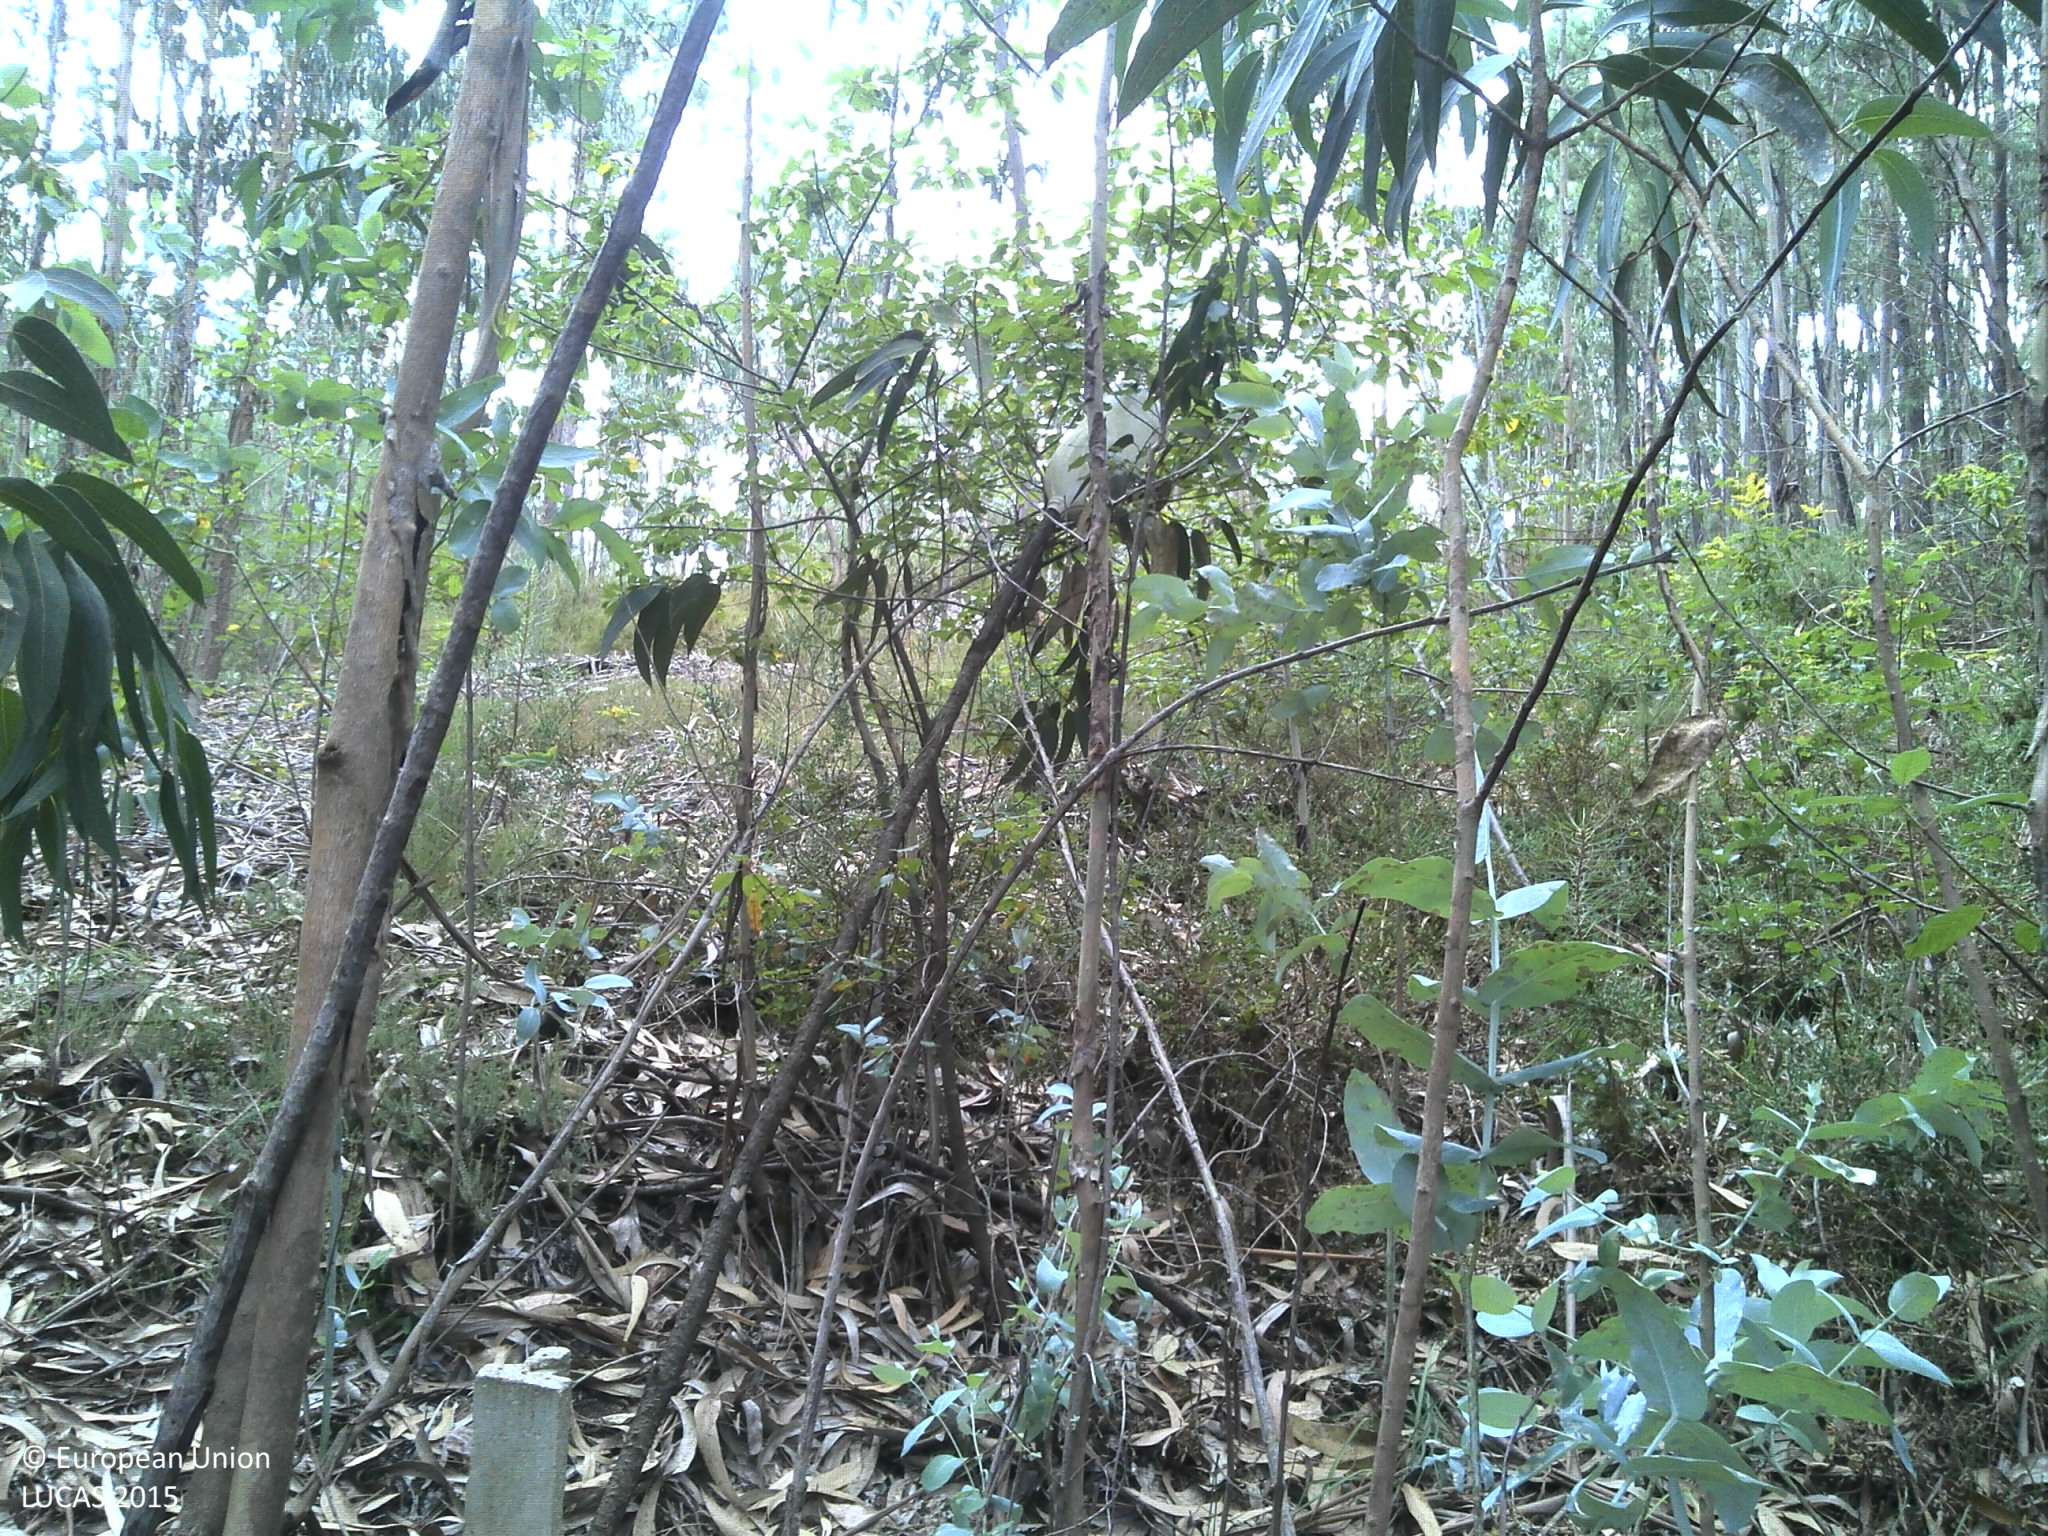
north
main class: Woodland
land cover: Broadleaved woodland
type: boreal forest
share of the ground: 50 - 75 %
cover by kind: broadleaved forest trees 60 %, shrubs 25 %, unconsolidated bare surface 10 %, herbaceous plants 5 %
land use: Forestry
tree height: > 5 m
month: June
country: PT
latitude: 40.7670
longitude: -8.4933
